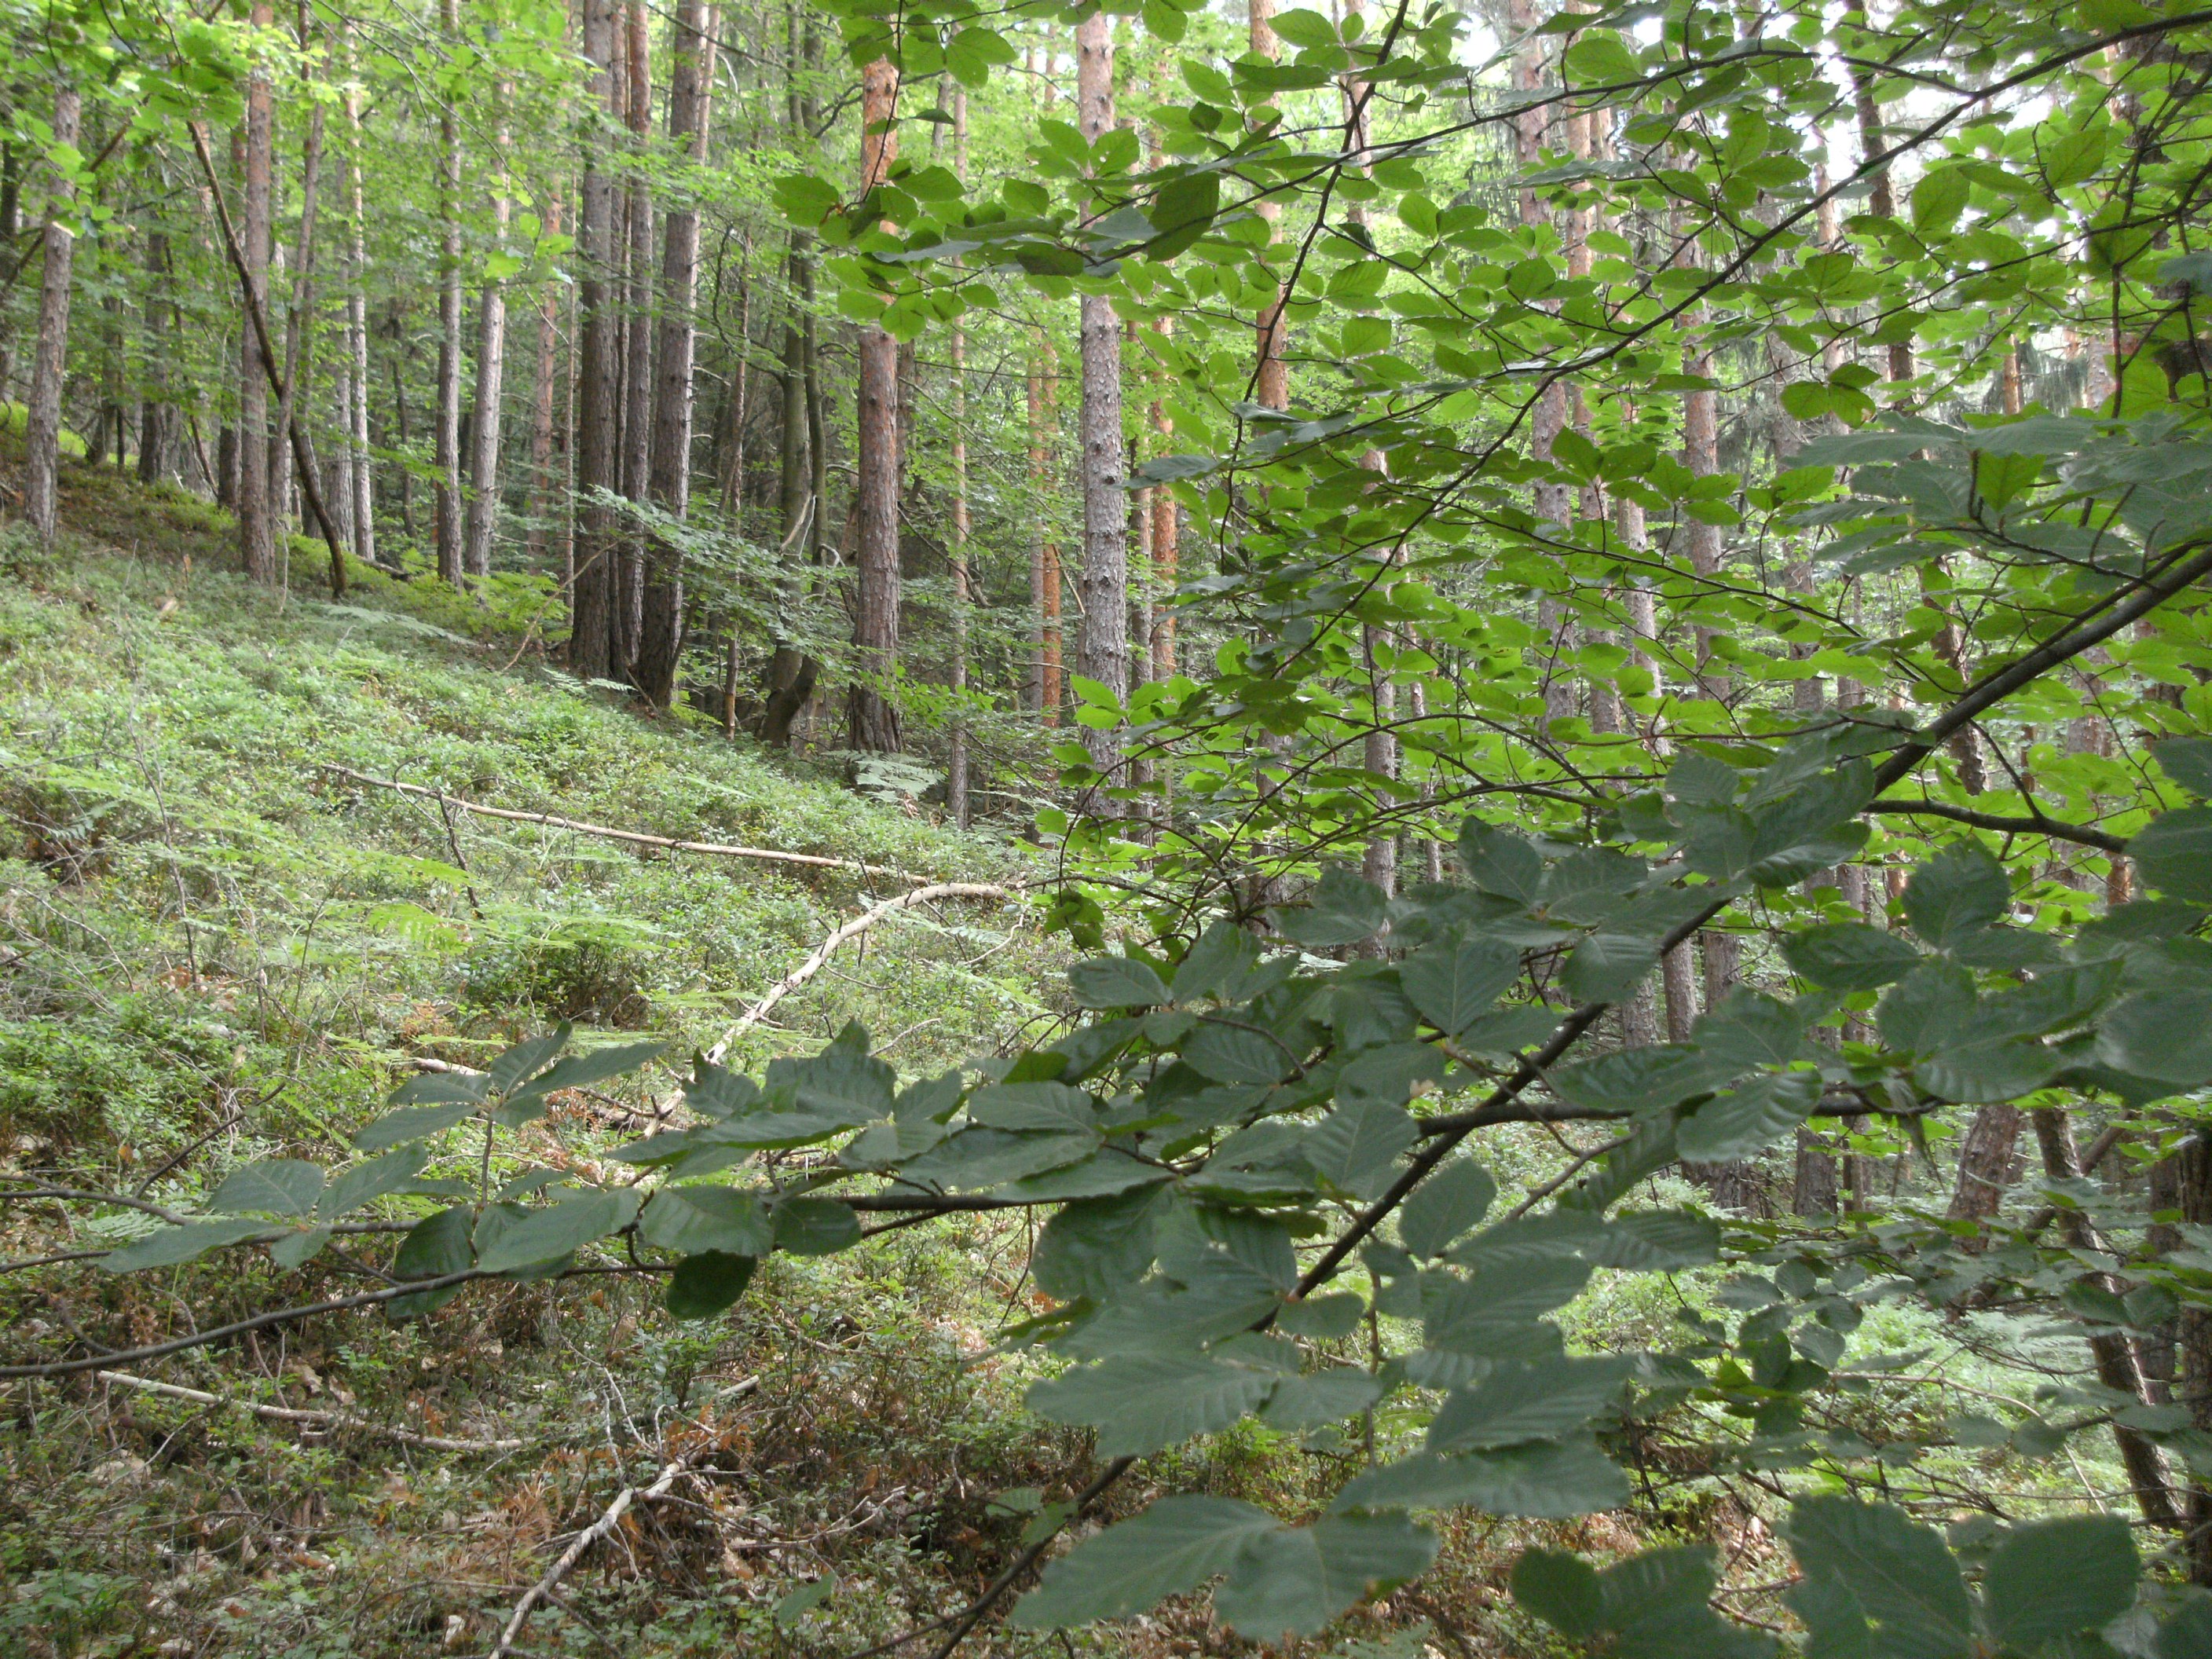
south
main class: Woodland
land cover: Pine dominated coniferous woodland
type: hemiboreal forest and nemoral coniferous forest and mixed broadleaved-coniferous forest
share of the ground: > 75 %
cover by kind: coniferous forest trees 70 %, broadleaved forest trees 10 %, shrubs 10 %, herbaceous plants 10 %
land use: Forestry
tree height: > 5 m
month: July
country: AT
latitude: 46.6216
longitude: 14.8168
